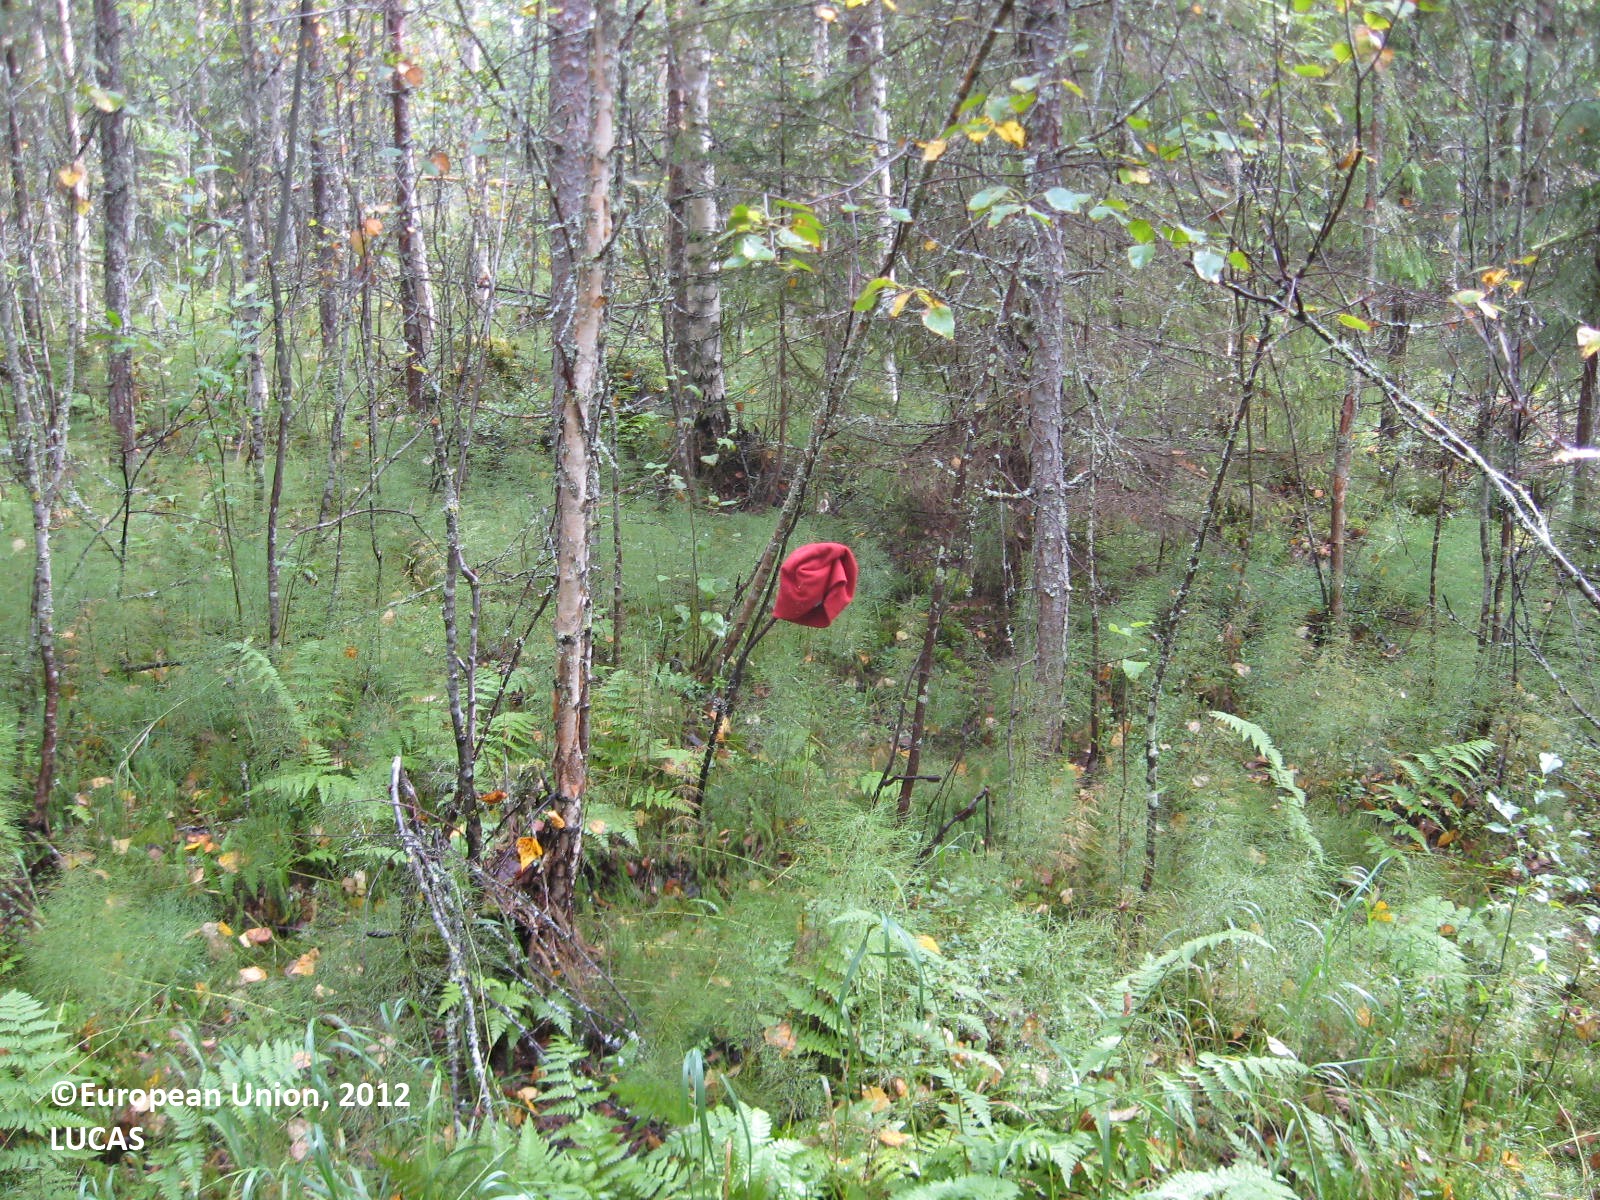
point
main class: Woodland
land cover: Other mixed woodland
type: boreal forest
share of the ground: > 75 %
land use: Forestry
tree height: > 5 m
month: August
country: FI
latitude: 63.4655
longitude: 29.8021
